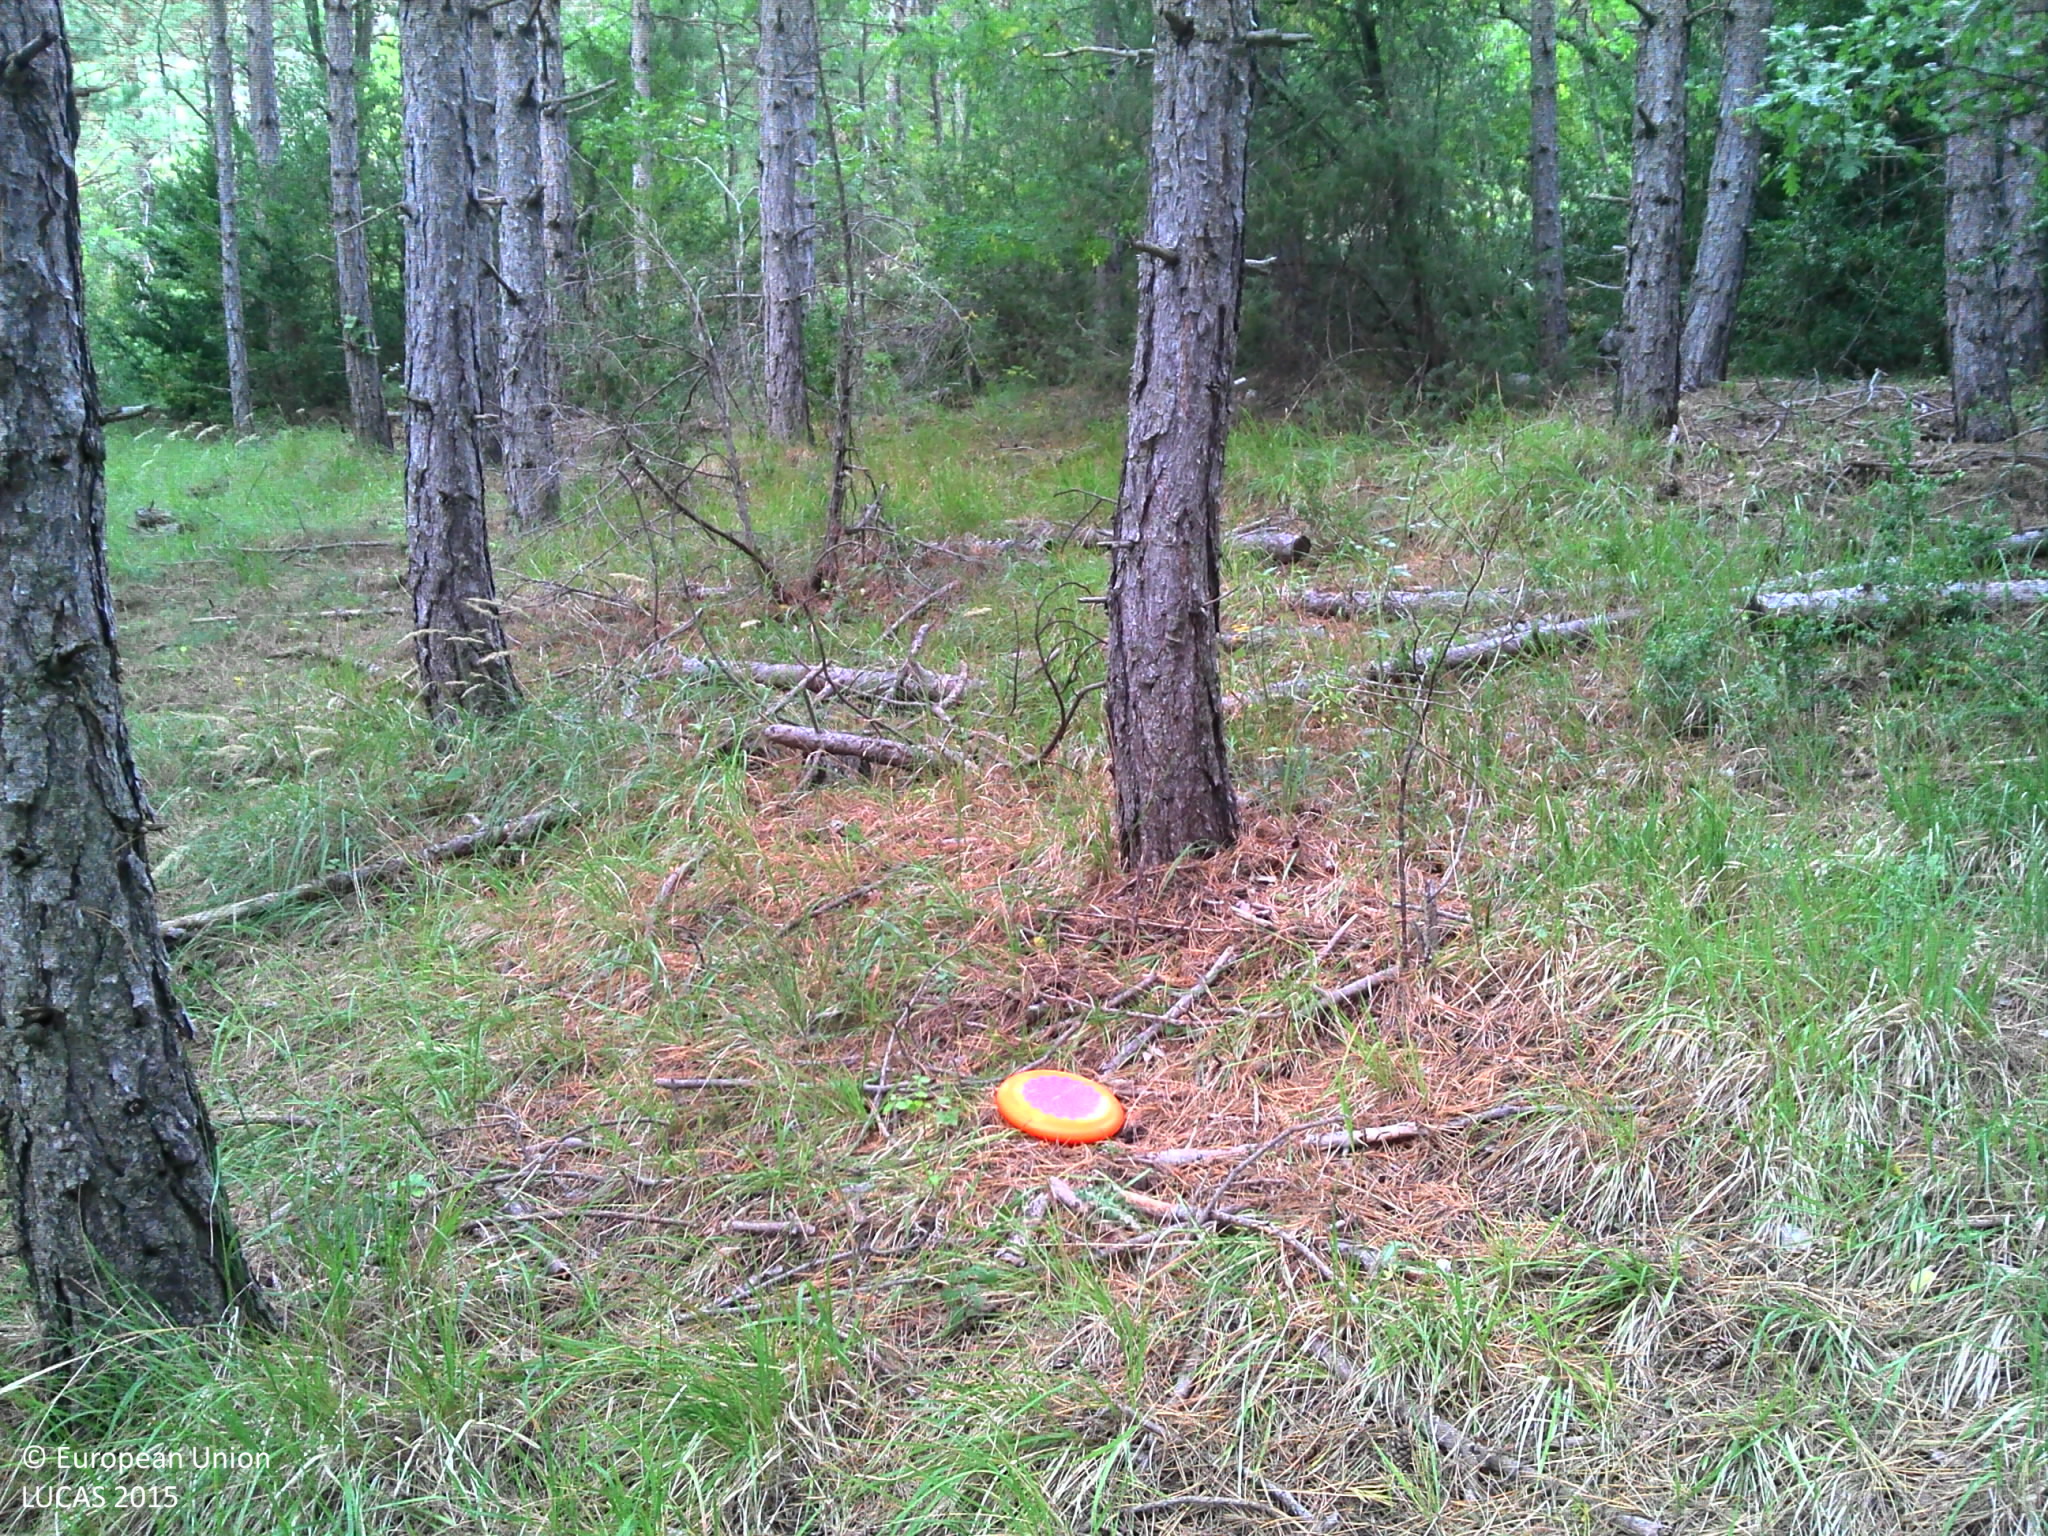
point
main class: Woodland
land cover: Pine dominated coniferous woodland
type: exotic forest
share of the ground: > 75 %
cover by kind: coniferous forest trees 80 %, herbaceous plants 15 %, shrubs 5 %
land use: Forestry
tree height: > 5 m
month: September
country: FR
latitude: 44.4716
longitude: 5.5444
